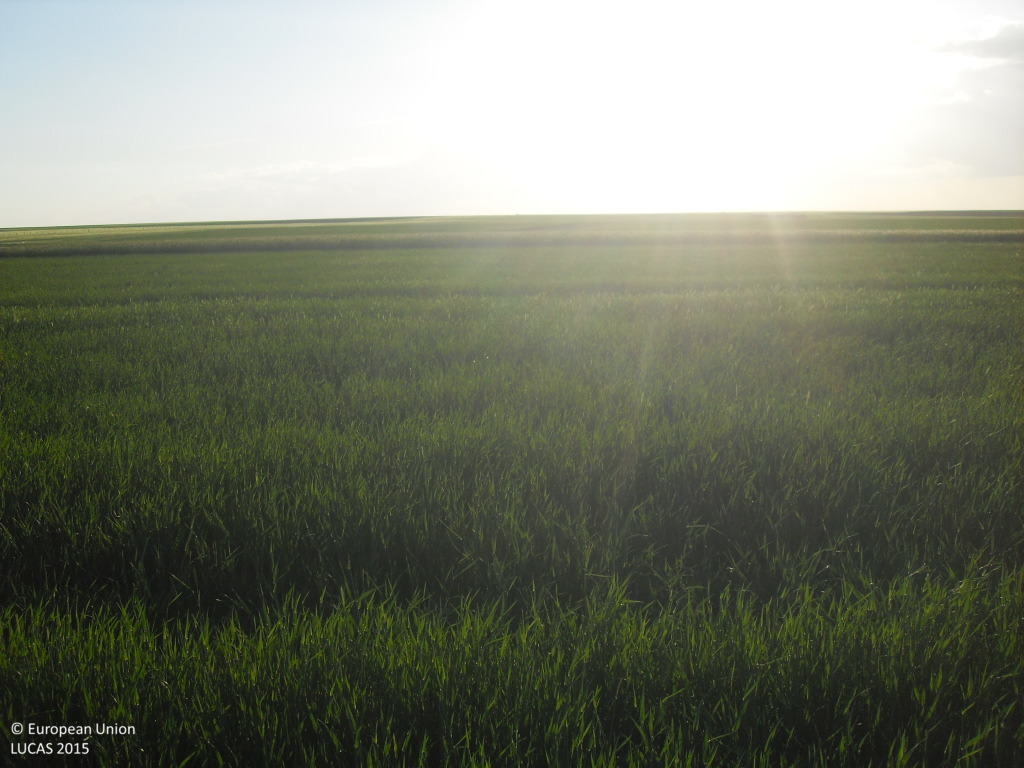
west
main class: Cropland
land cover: Barley
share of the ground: > 75 %
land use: Agriculture (excluding fallow land and kitchen gardens)
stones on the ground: < 10 %
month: May
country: ES
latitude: 40.8648
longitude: -5.2664
